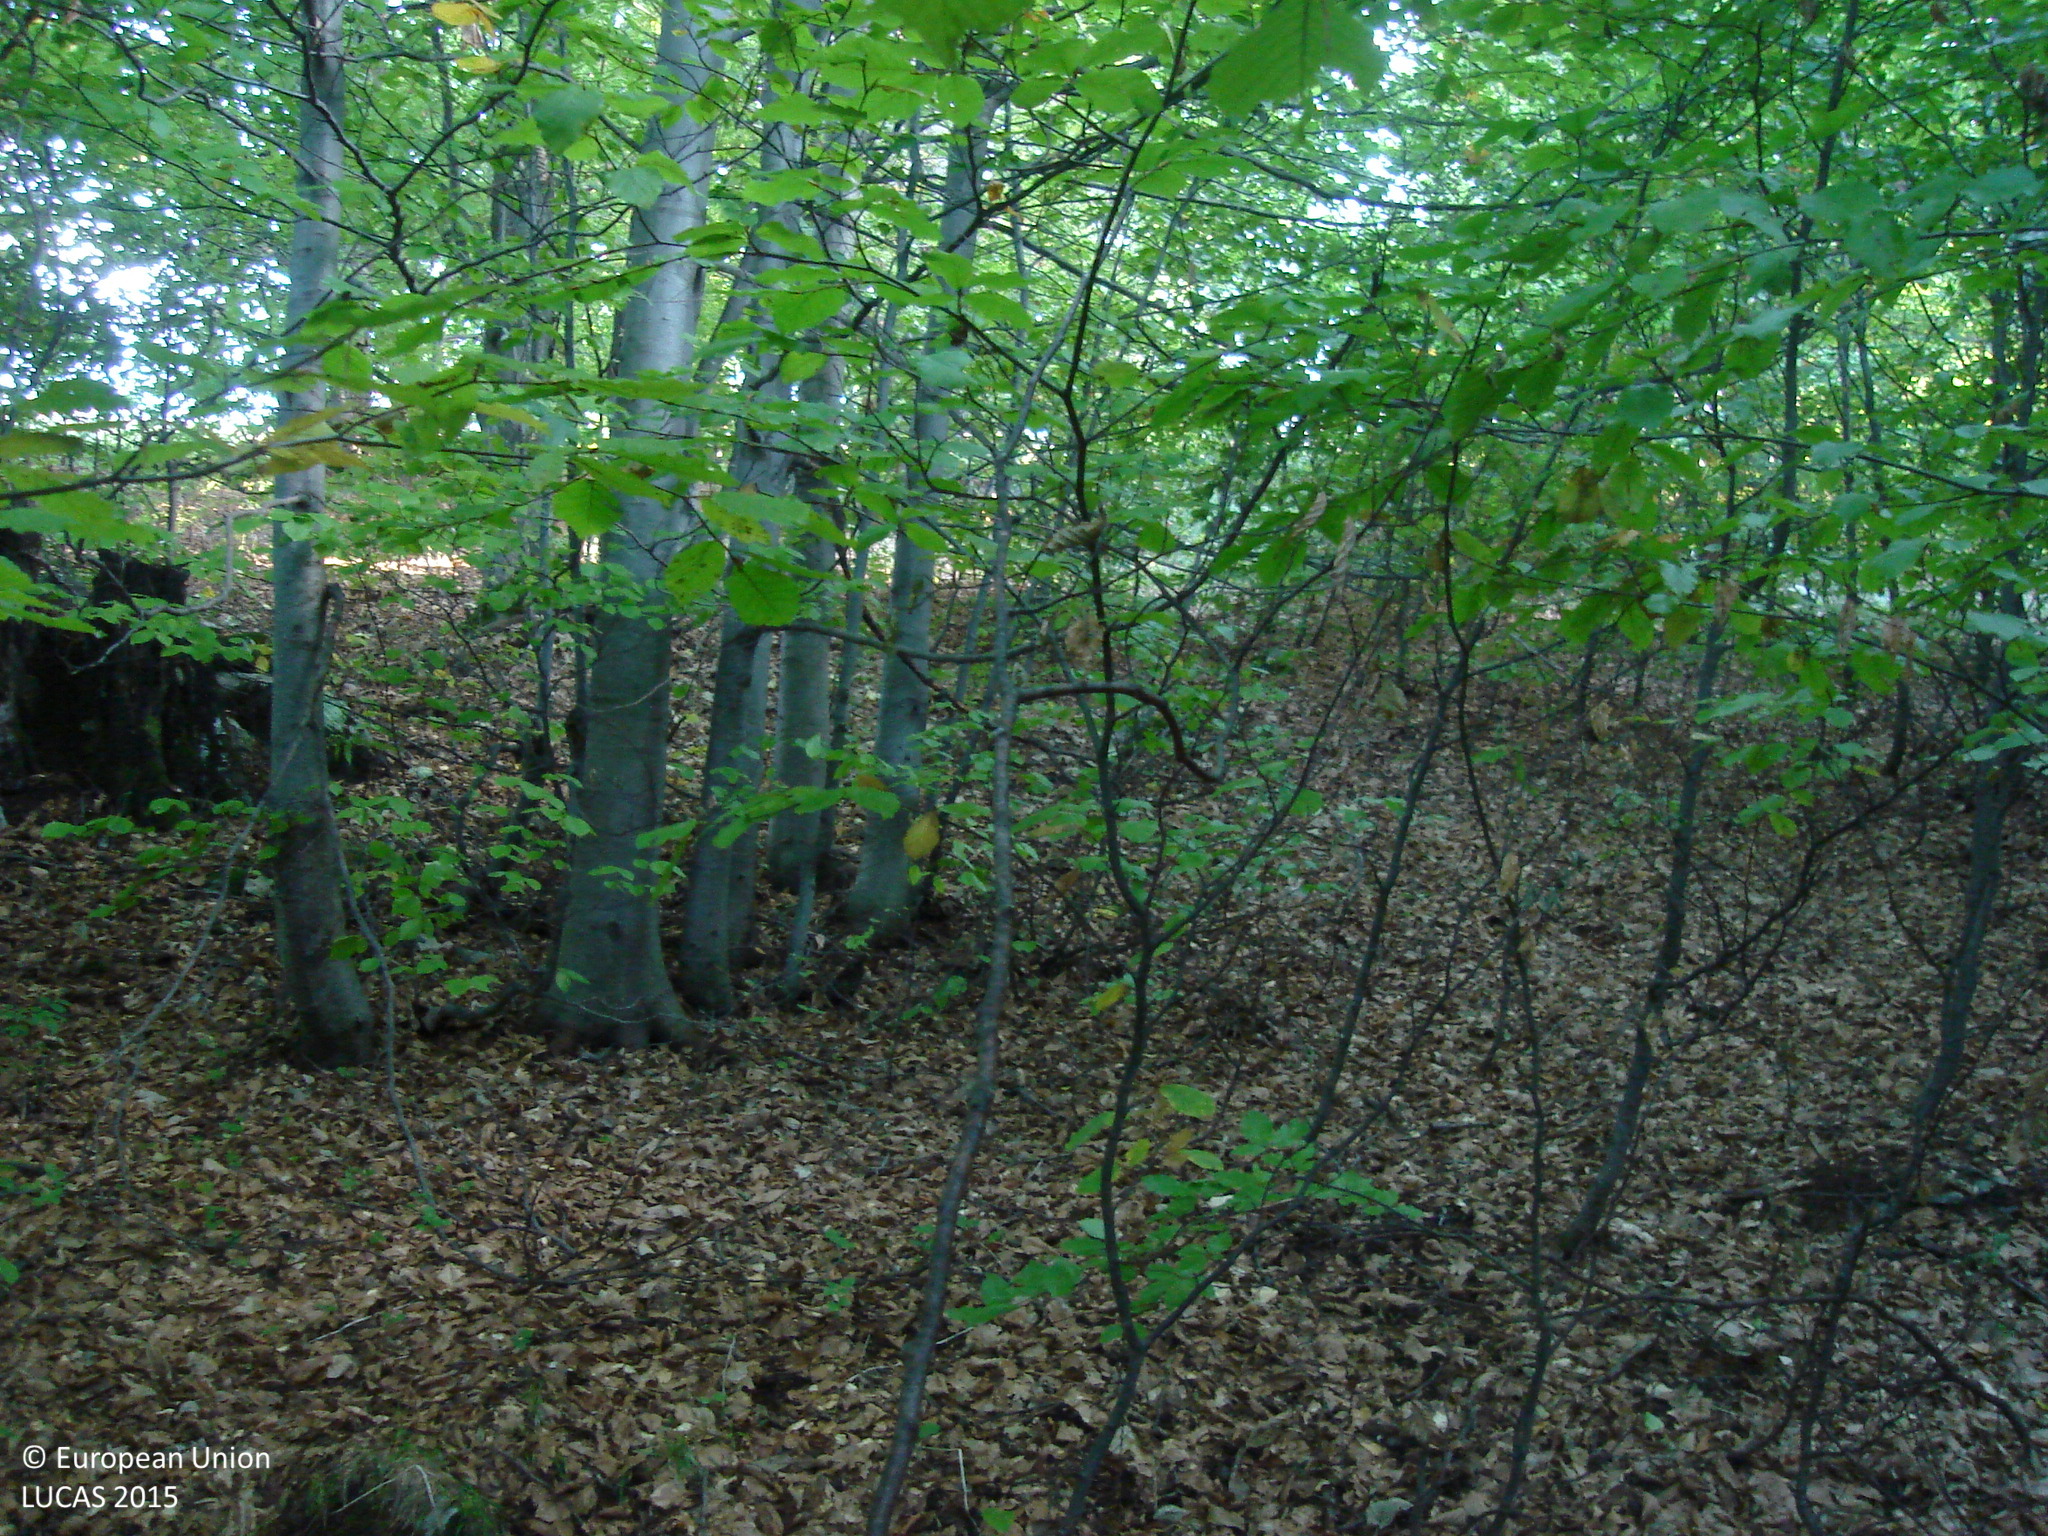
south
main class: Woodland
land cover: Broadleaved woodland
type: beech forest
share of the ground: > 75 %
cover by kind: broadleaved forest trees 85 %, consolidated bare surface 10 %, lichens and mosses 5 %
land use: Forestry
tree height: > 5 m
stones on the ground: < 10 %
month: October
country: BG
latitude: 43.1442
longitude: 23.4300
